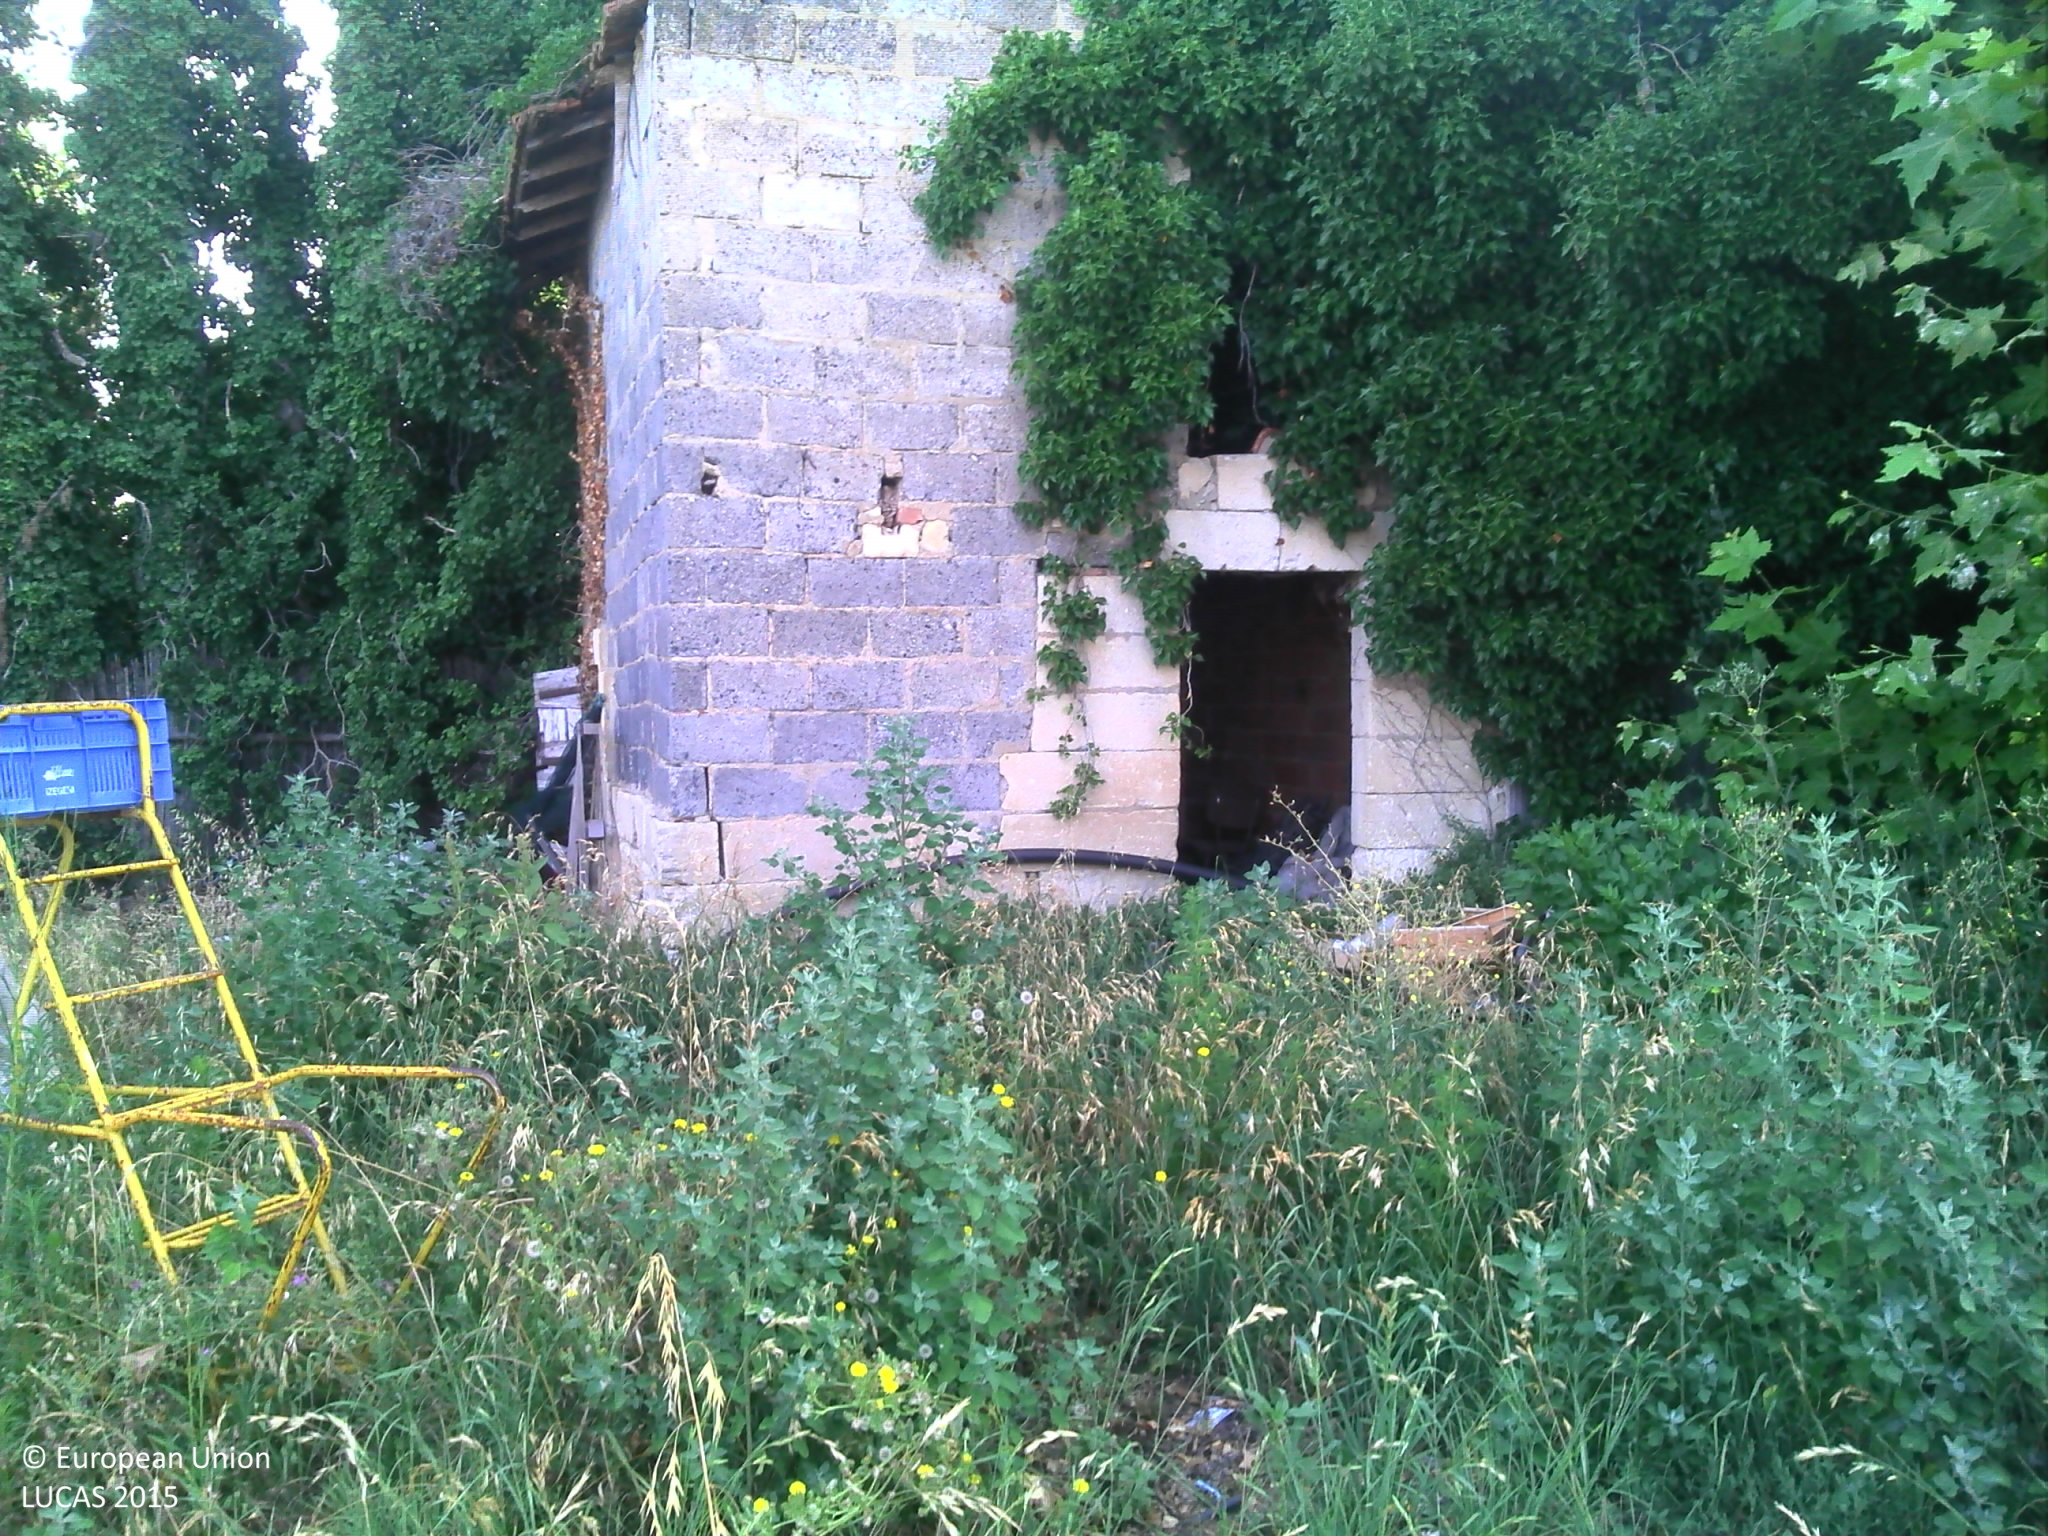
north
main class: Grassland
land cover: Spontaneously vegetated surfaces
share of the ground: > 75 %
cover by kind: herbaceous plants 100 %
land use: Agriculture (excluding fallow land and kitchen gardens)
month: July
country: FR
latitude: 43.8778
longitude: 4.8191
